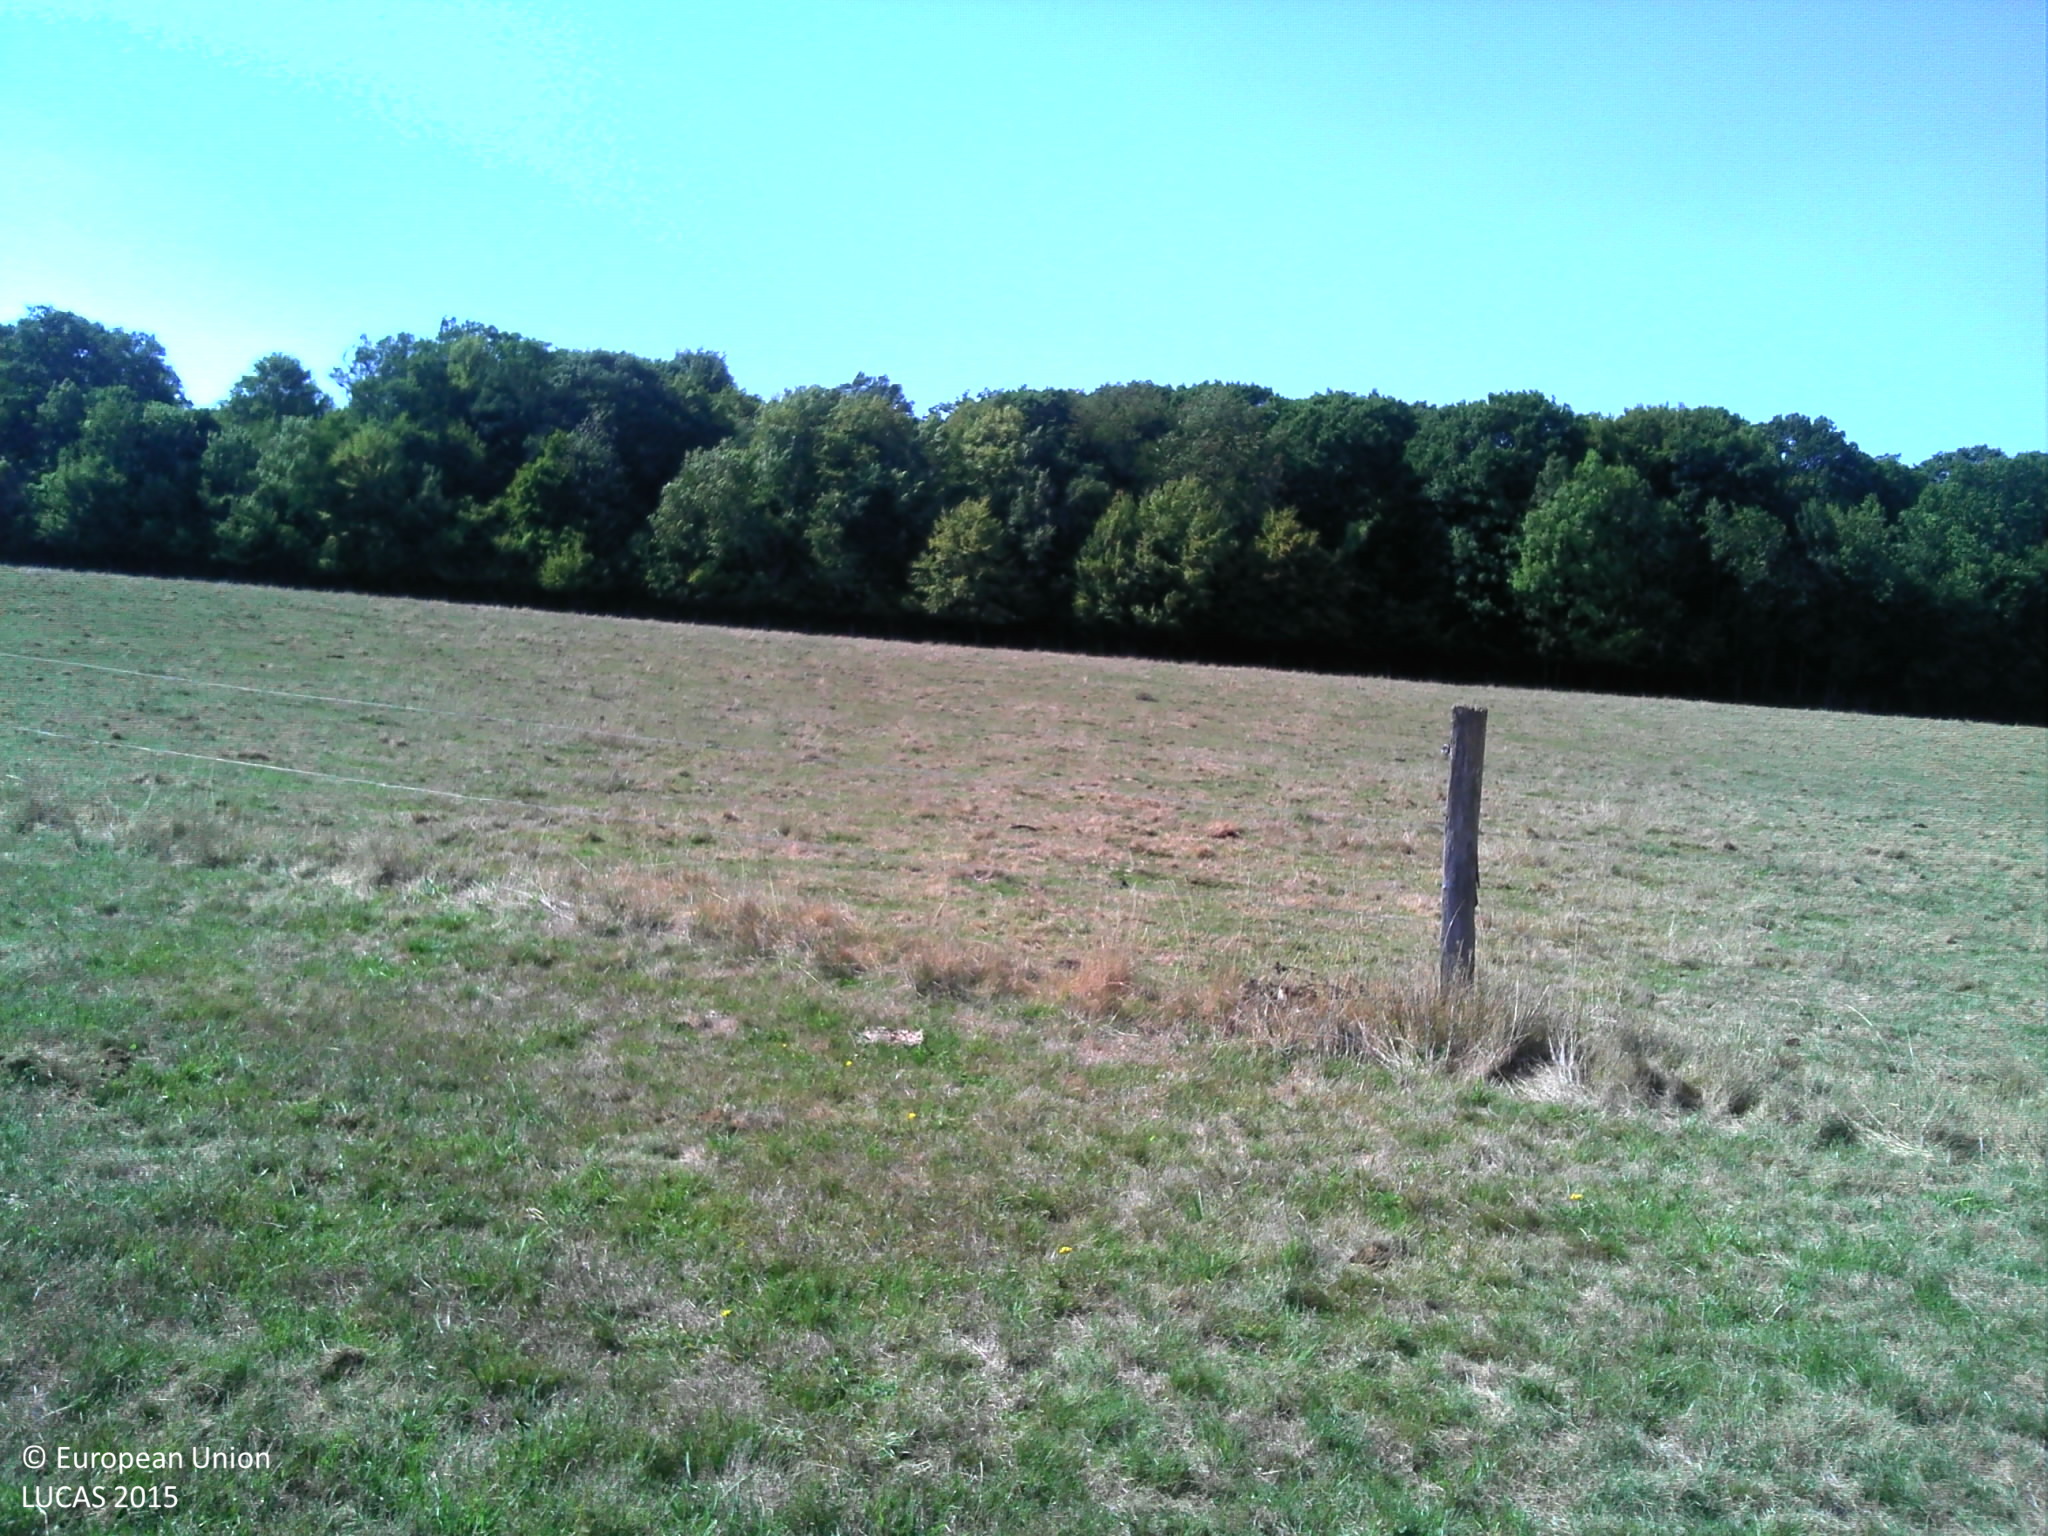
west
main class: Grassland
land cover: Grassland without tree/shrub cover
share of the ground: > 75 %
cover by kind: herbaceous plants 85 %, consolidated bare surface 15 %
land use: Agriculture (excluding fallow land and kitchen gardens)
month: September
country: FR
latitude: 48.6562
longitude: 6.0222
